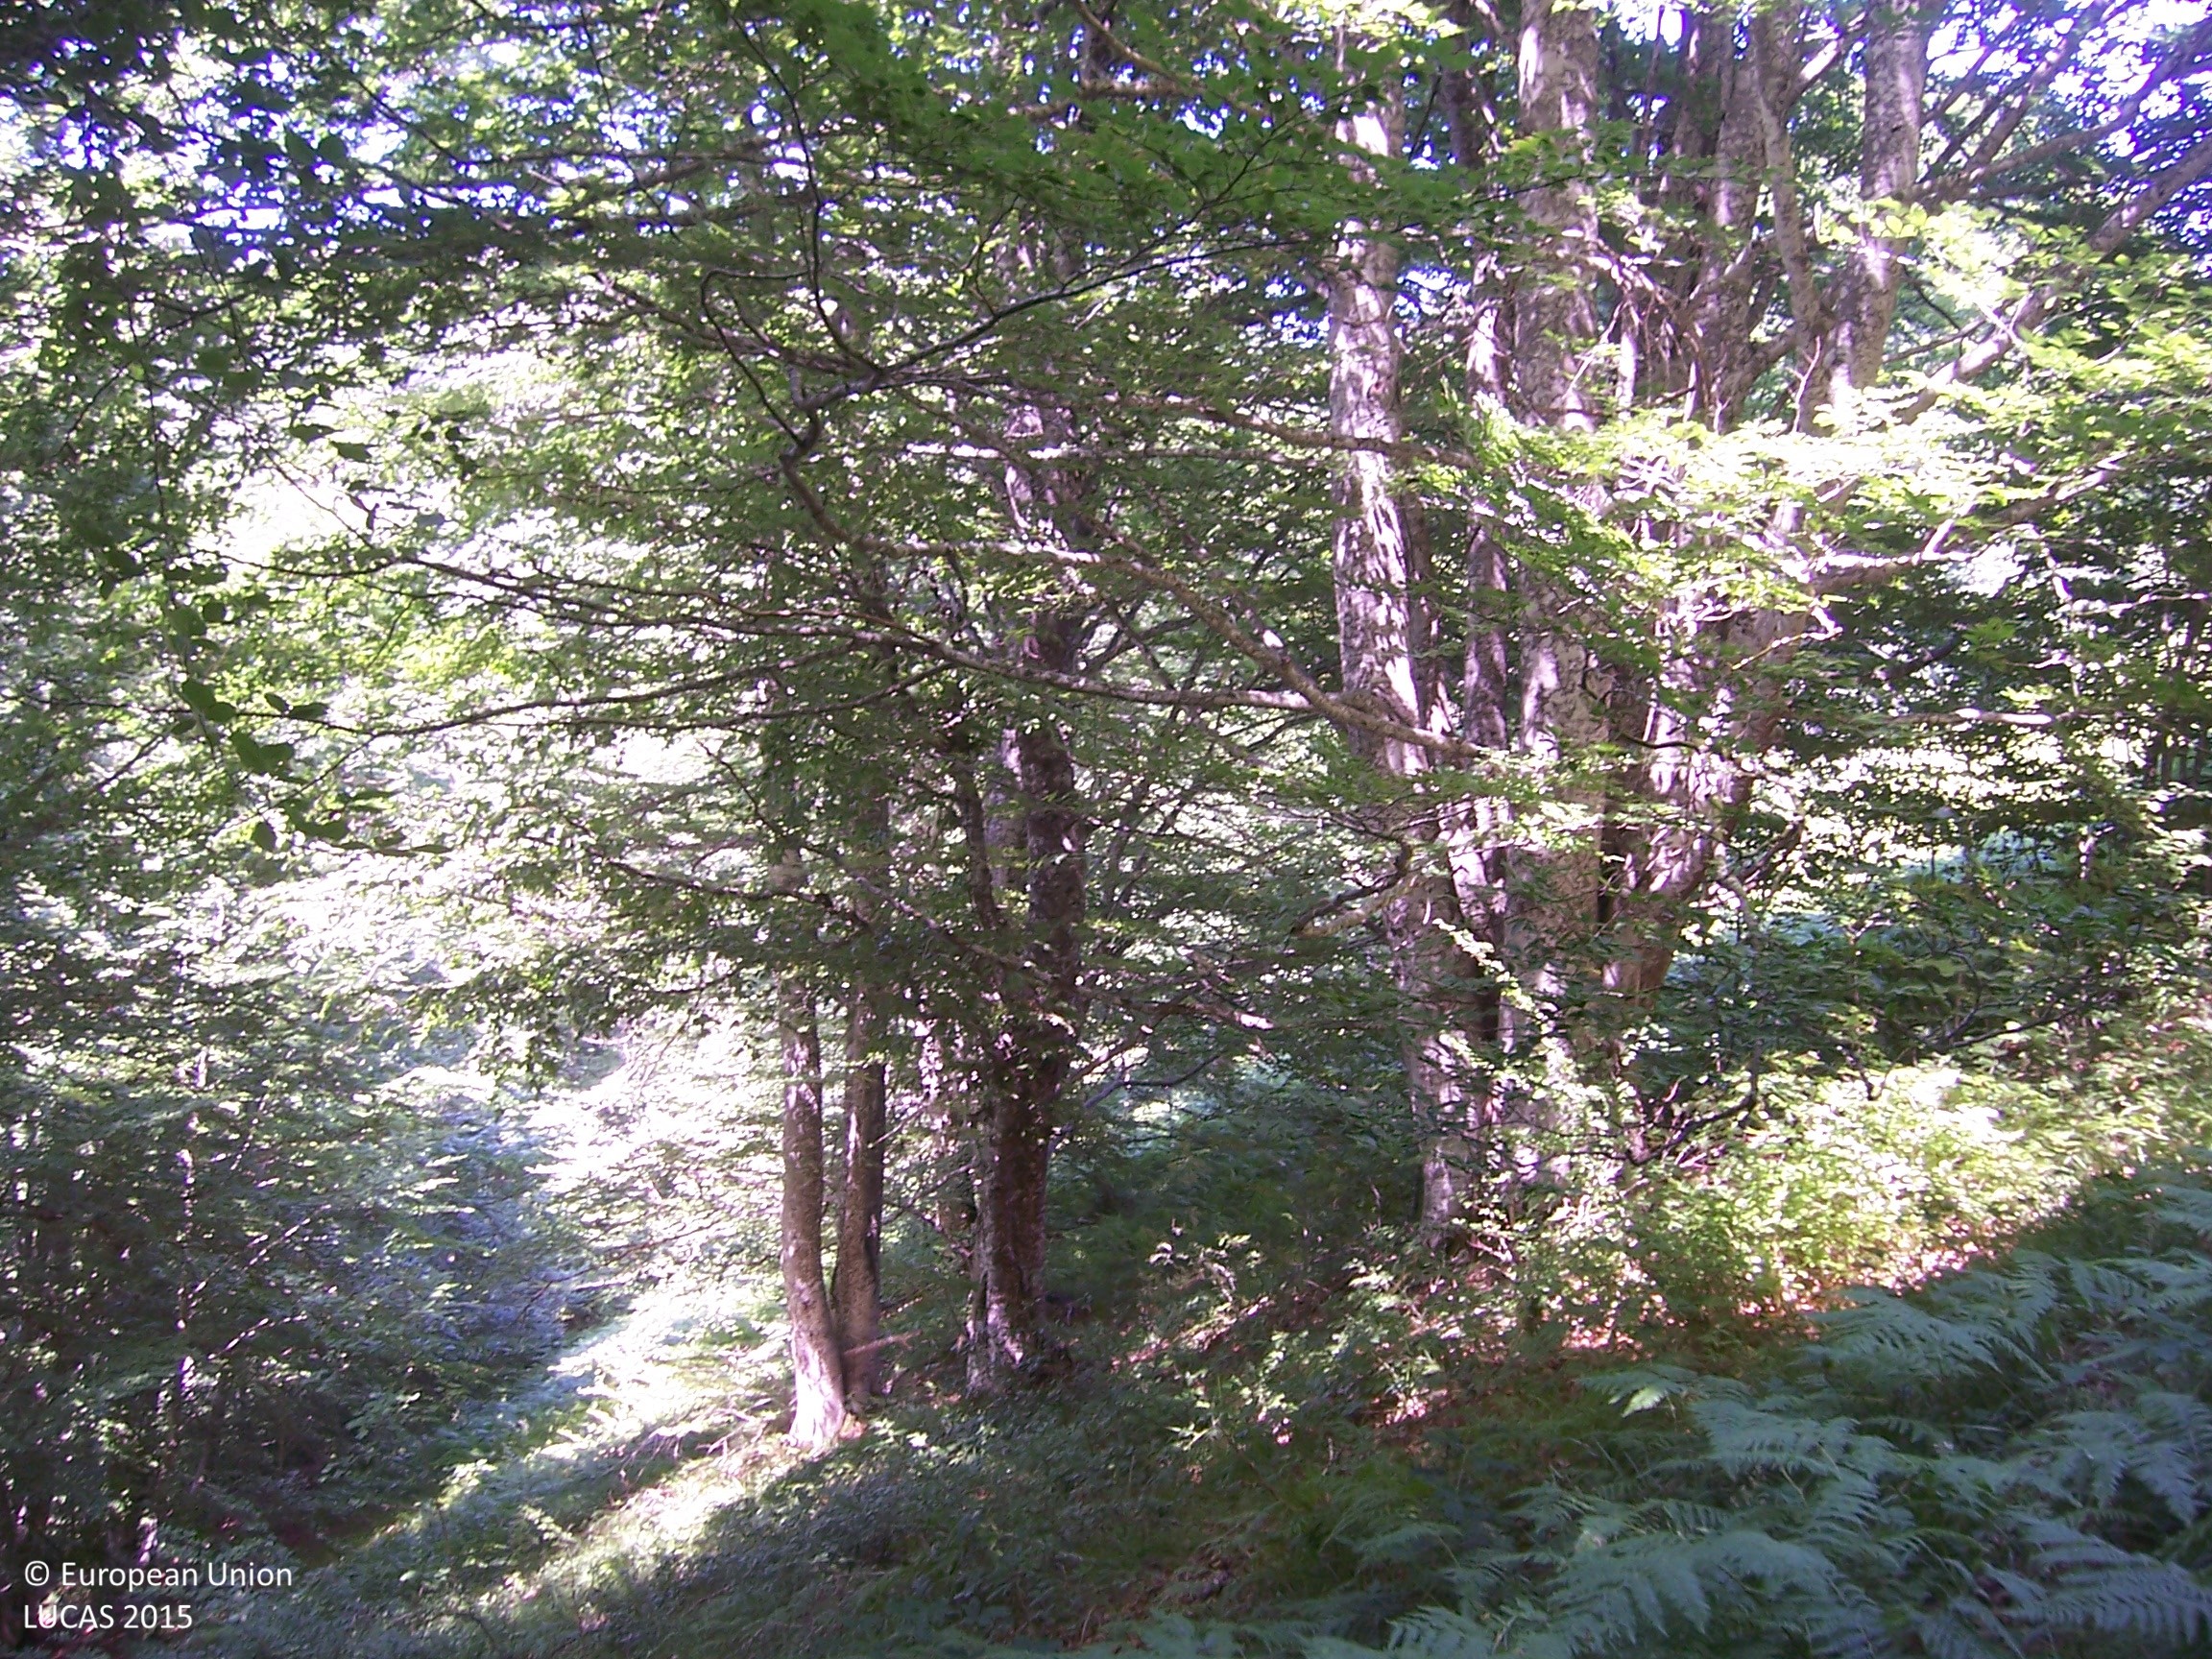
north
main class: Woodland
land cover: Broadleaved woodland
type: mountainous beech forest
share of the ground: > 75 %
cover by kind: broadleaved forest trees 100 %
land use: Forestry
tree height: > 5 m
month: July
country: ES
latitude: 42.9236
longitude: -1.1968
